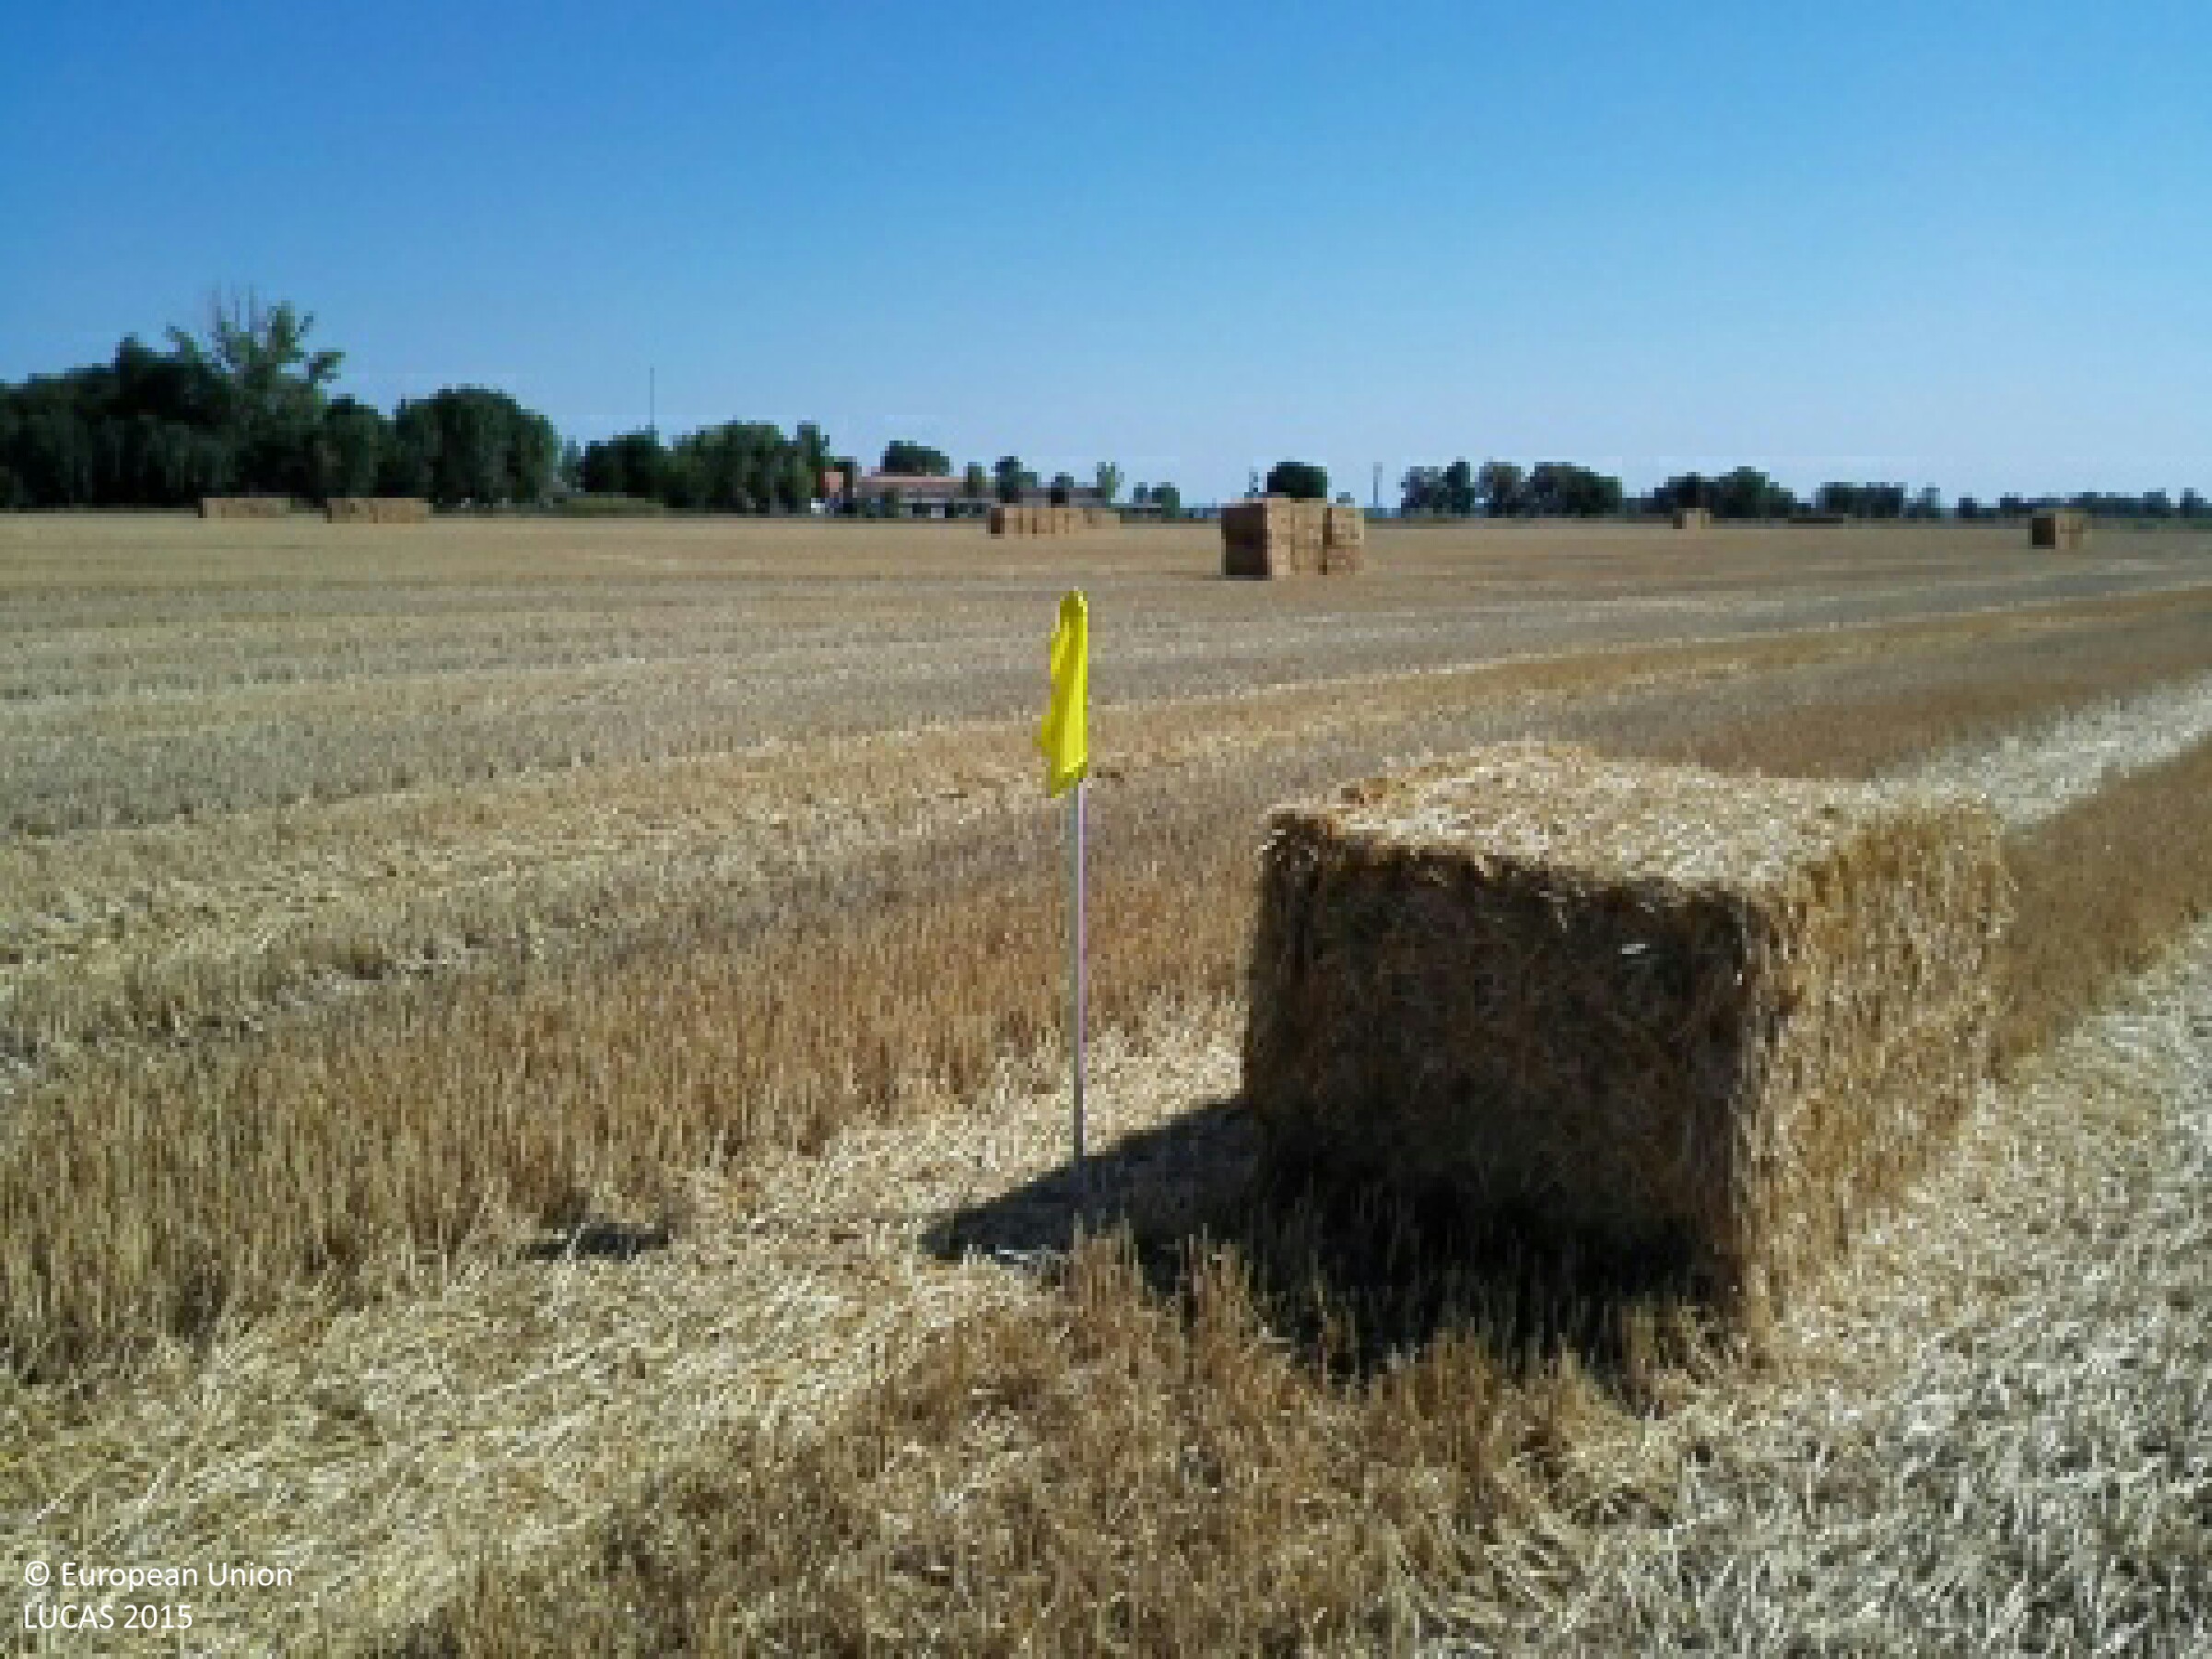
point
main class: Cropland
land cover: Common wheat
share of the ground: 50 - 75 %
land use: Agriculture (excluding fallow land and kitchen gardens)
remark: Harvested field
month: July
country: HU
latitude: 47.7139
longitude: 21.4666
